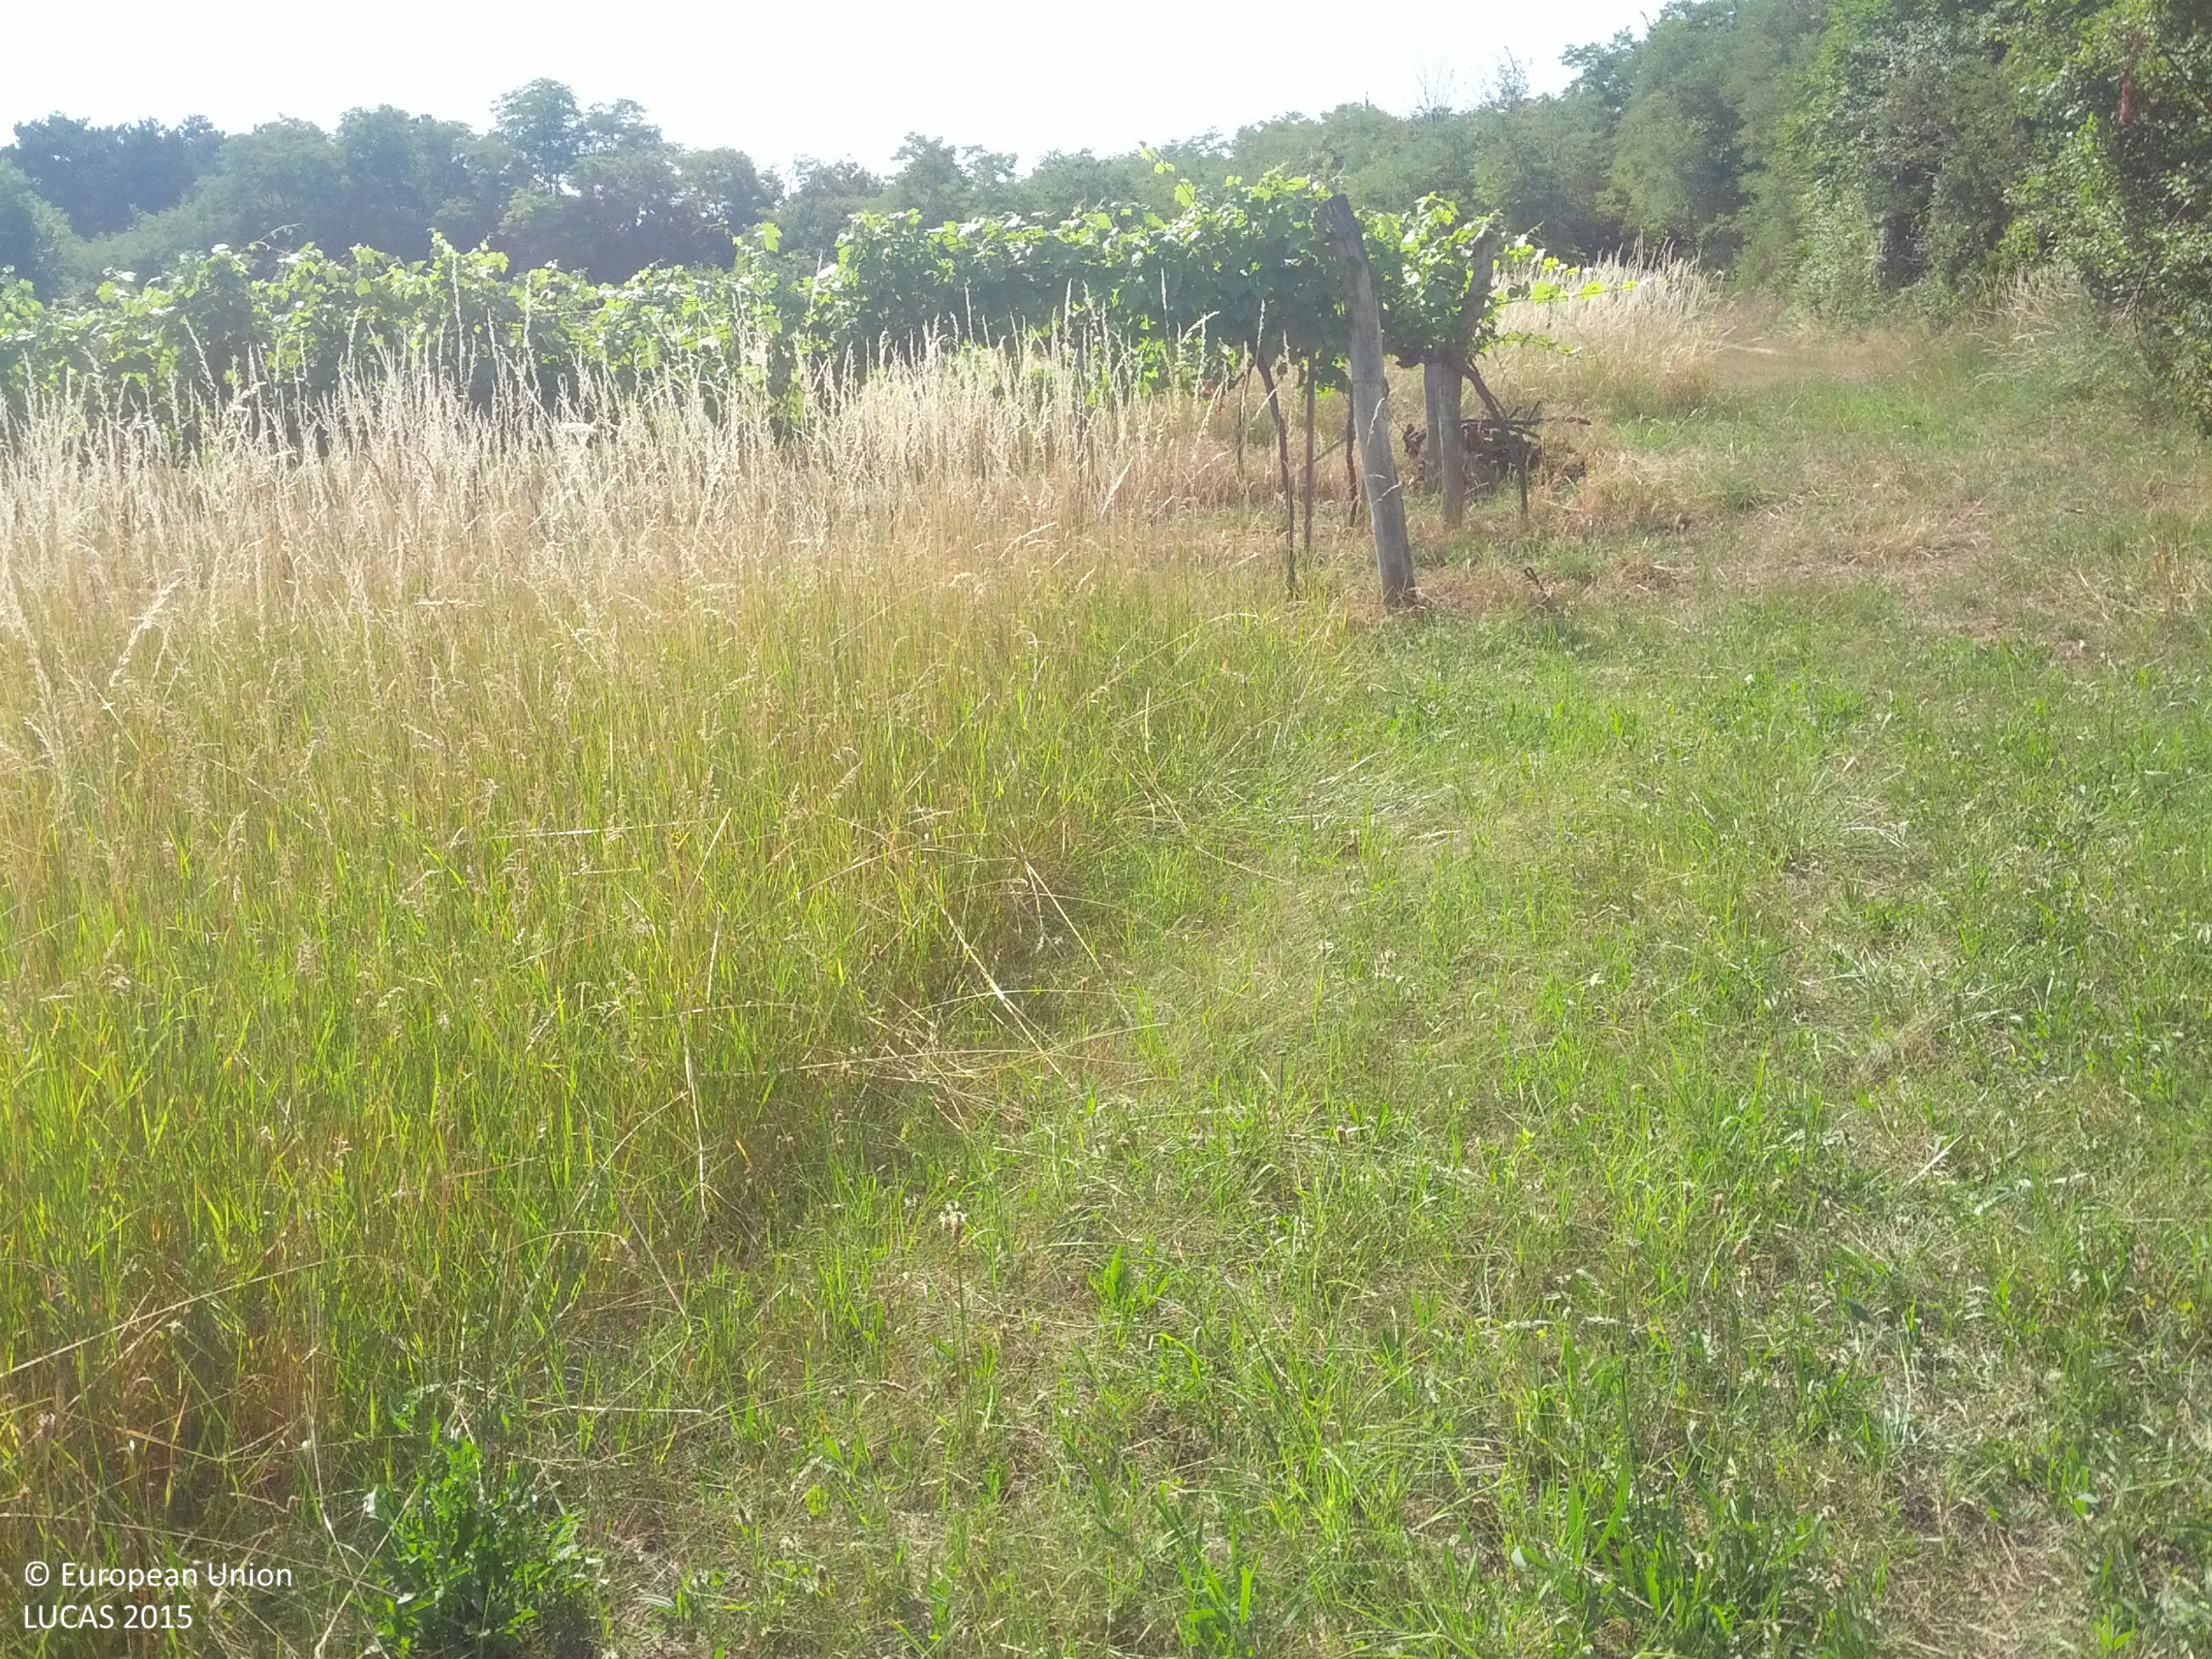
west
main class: Grassland
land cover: Grassland without tree/shrub cover
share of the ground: > 75 %
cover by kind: herbaceous plants 100 %
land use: Agriculture (excluding fallow land and kitchen gardens)
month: July
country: AT
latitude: 48.5083
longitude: 16.6800
